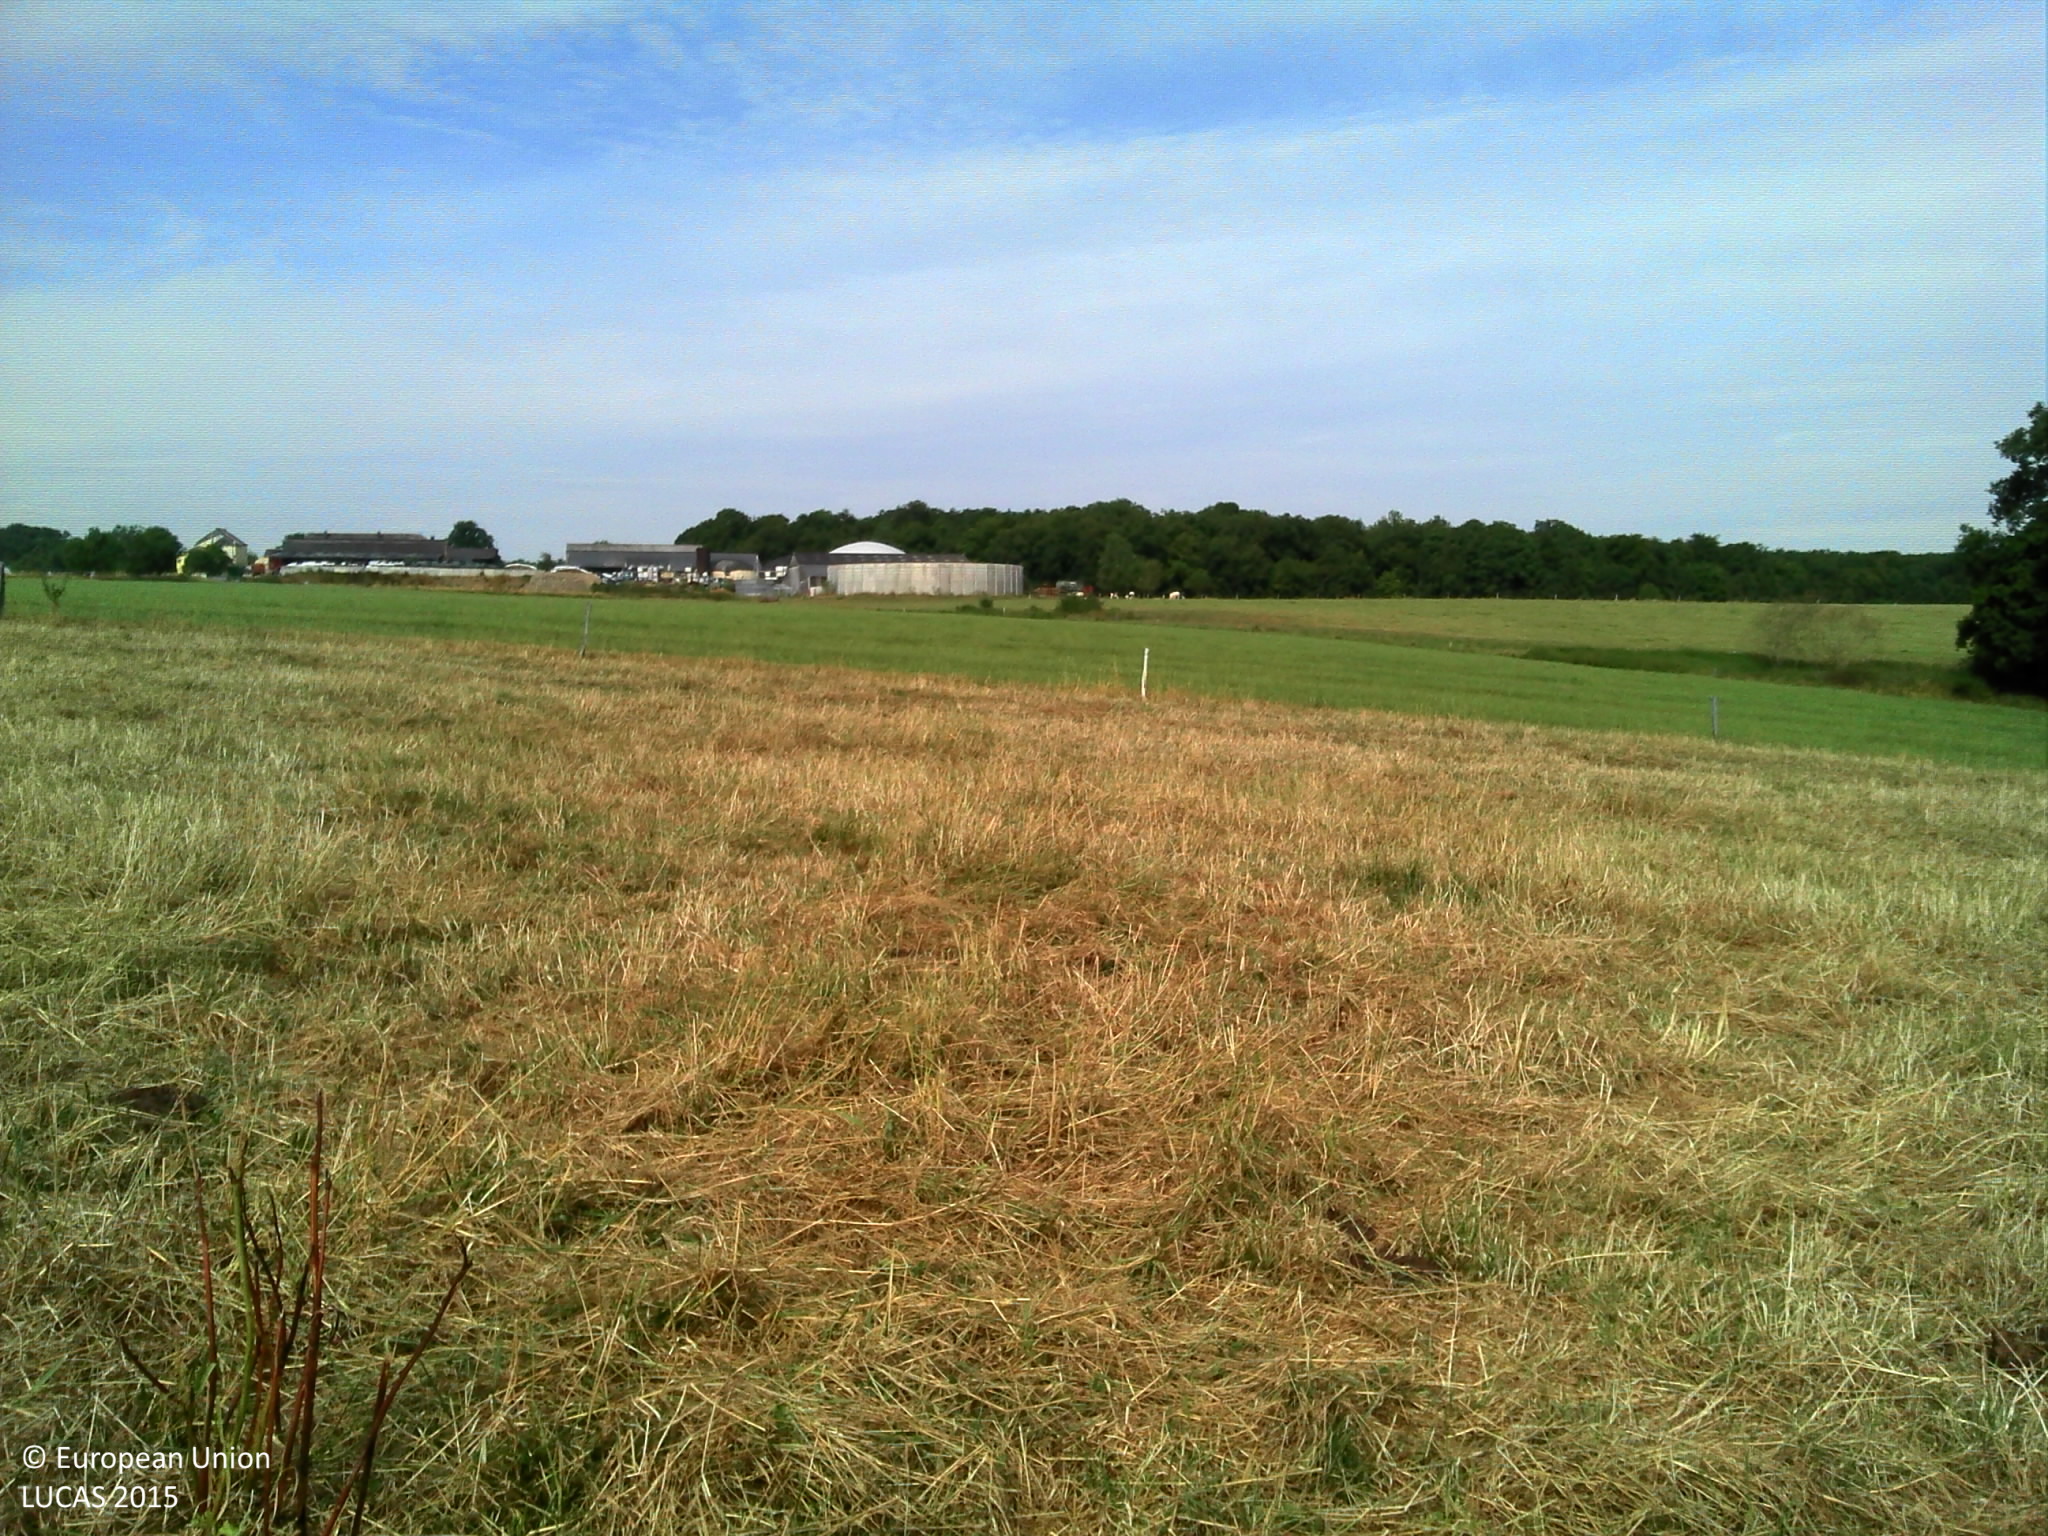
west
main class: Grassland
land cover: Grassland without tree/shrub cover
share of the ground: > 75 %
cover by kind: herbaceous plants 100 %
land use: Agriculture (excluding fallow land and kitchen gardens)
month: July
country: BE
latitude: 49.7476
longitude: 5.8216
